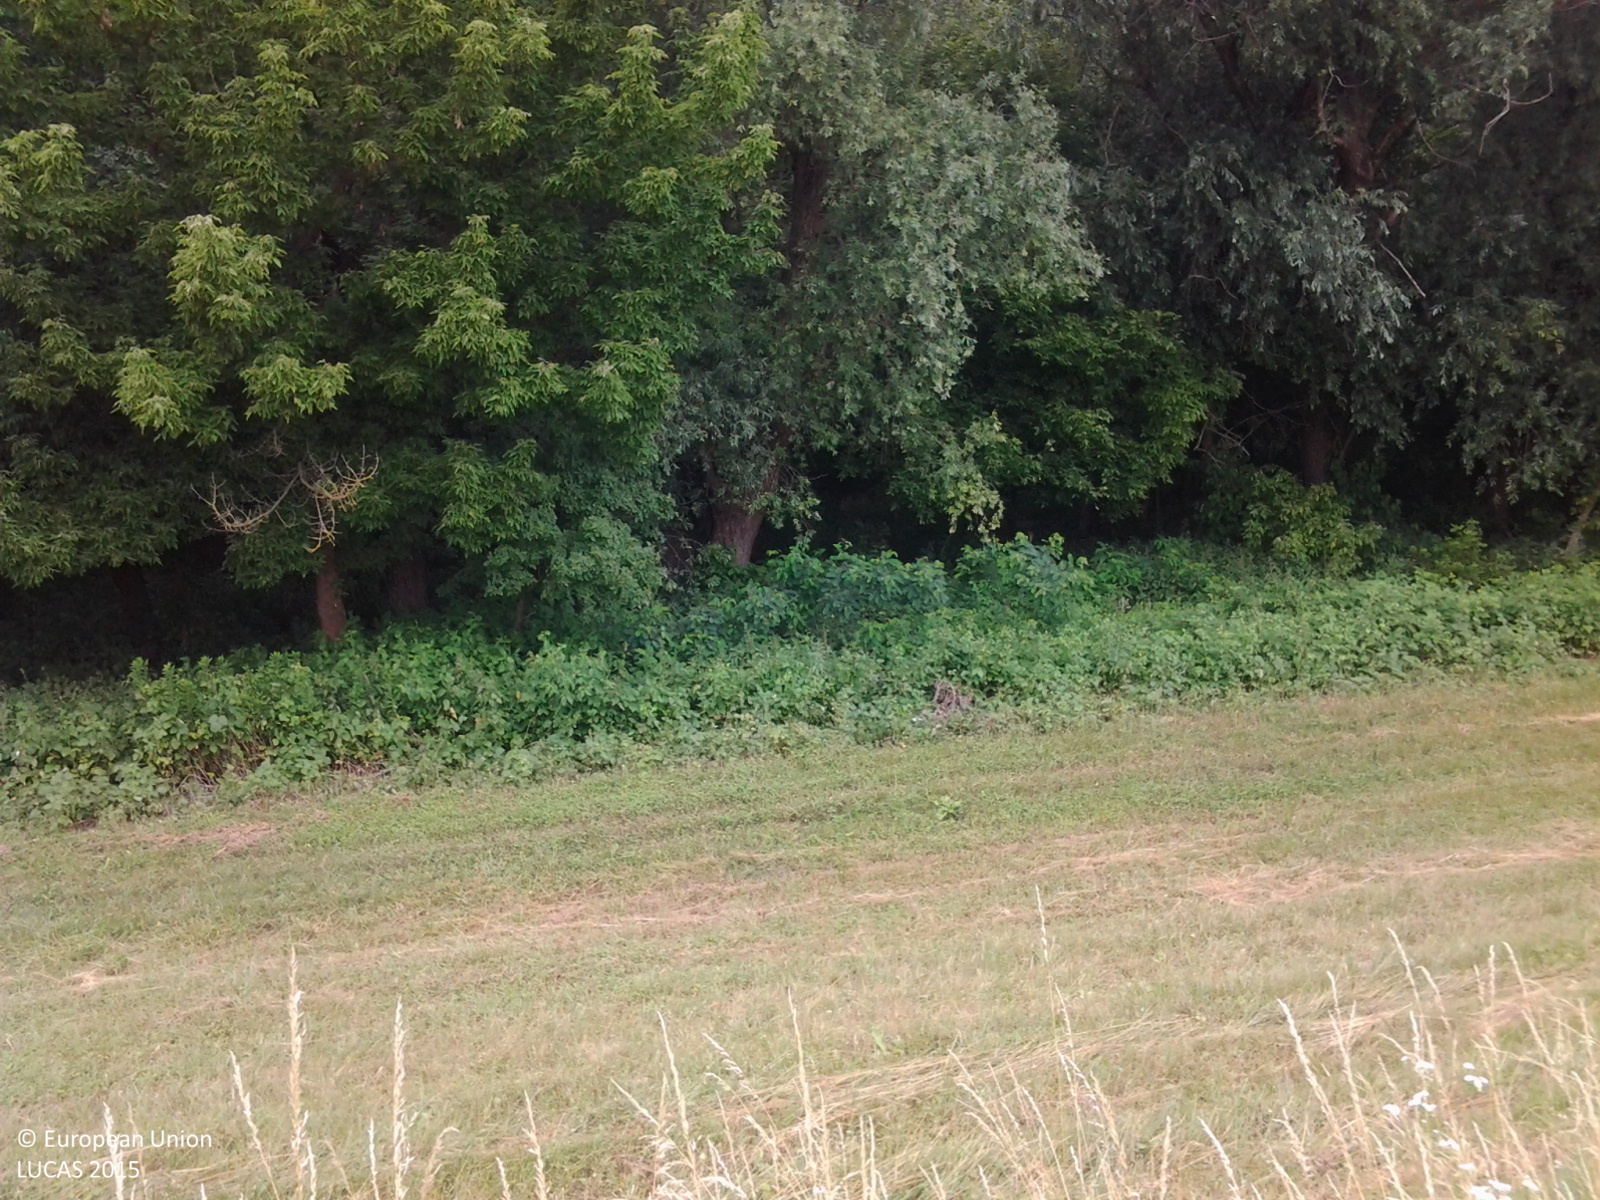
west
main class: Grassland
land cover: Grassland without tree/shrub cover
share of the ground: > 75 %
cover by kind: herbaceous plants 100 %
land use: Agriculture (excluding fallow land and kitchen gardens)
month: June
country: HU
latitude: 46.4659
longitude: 18.9332
